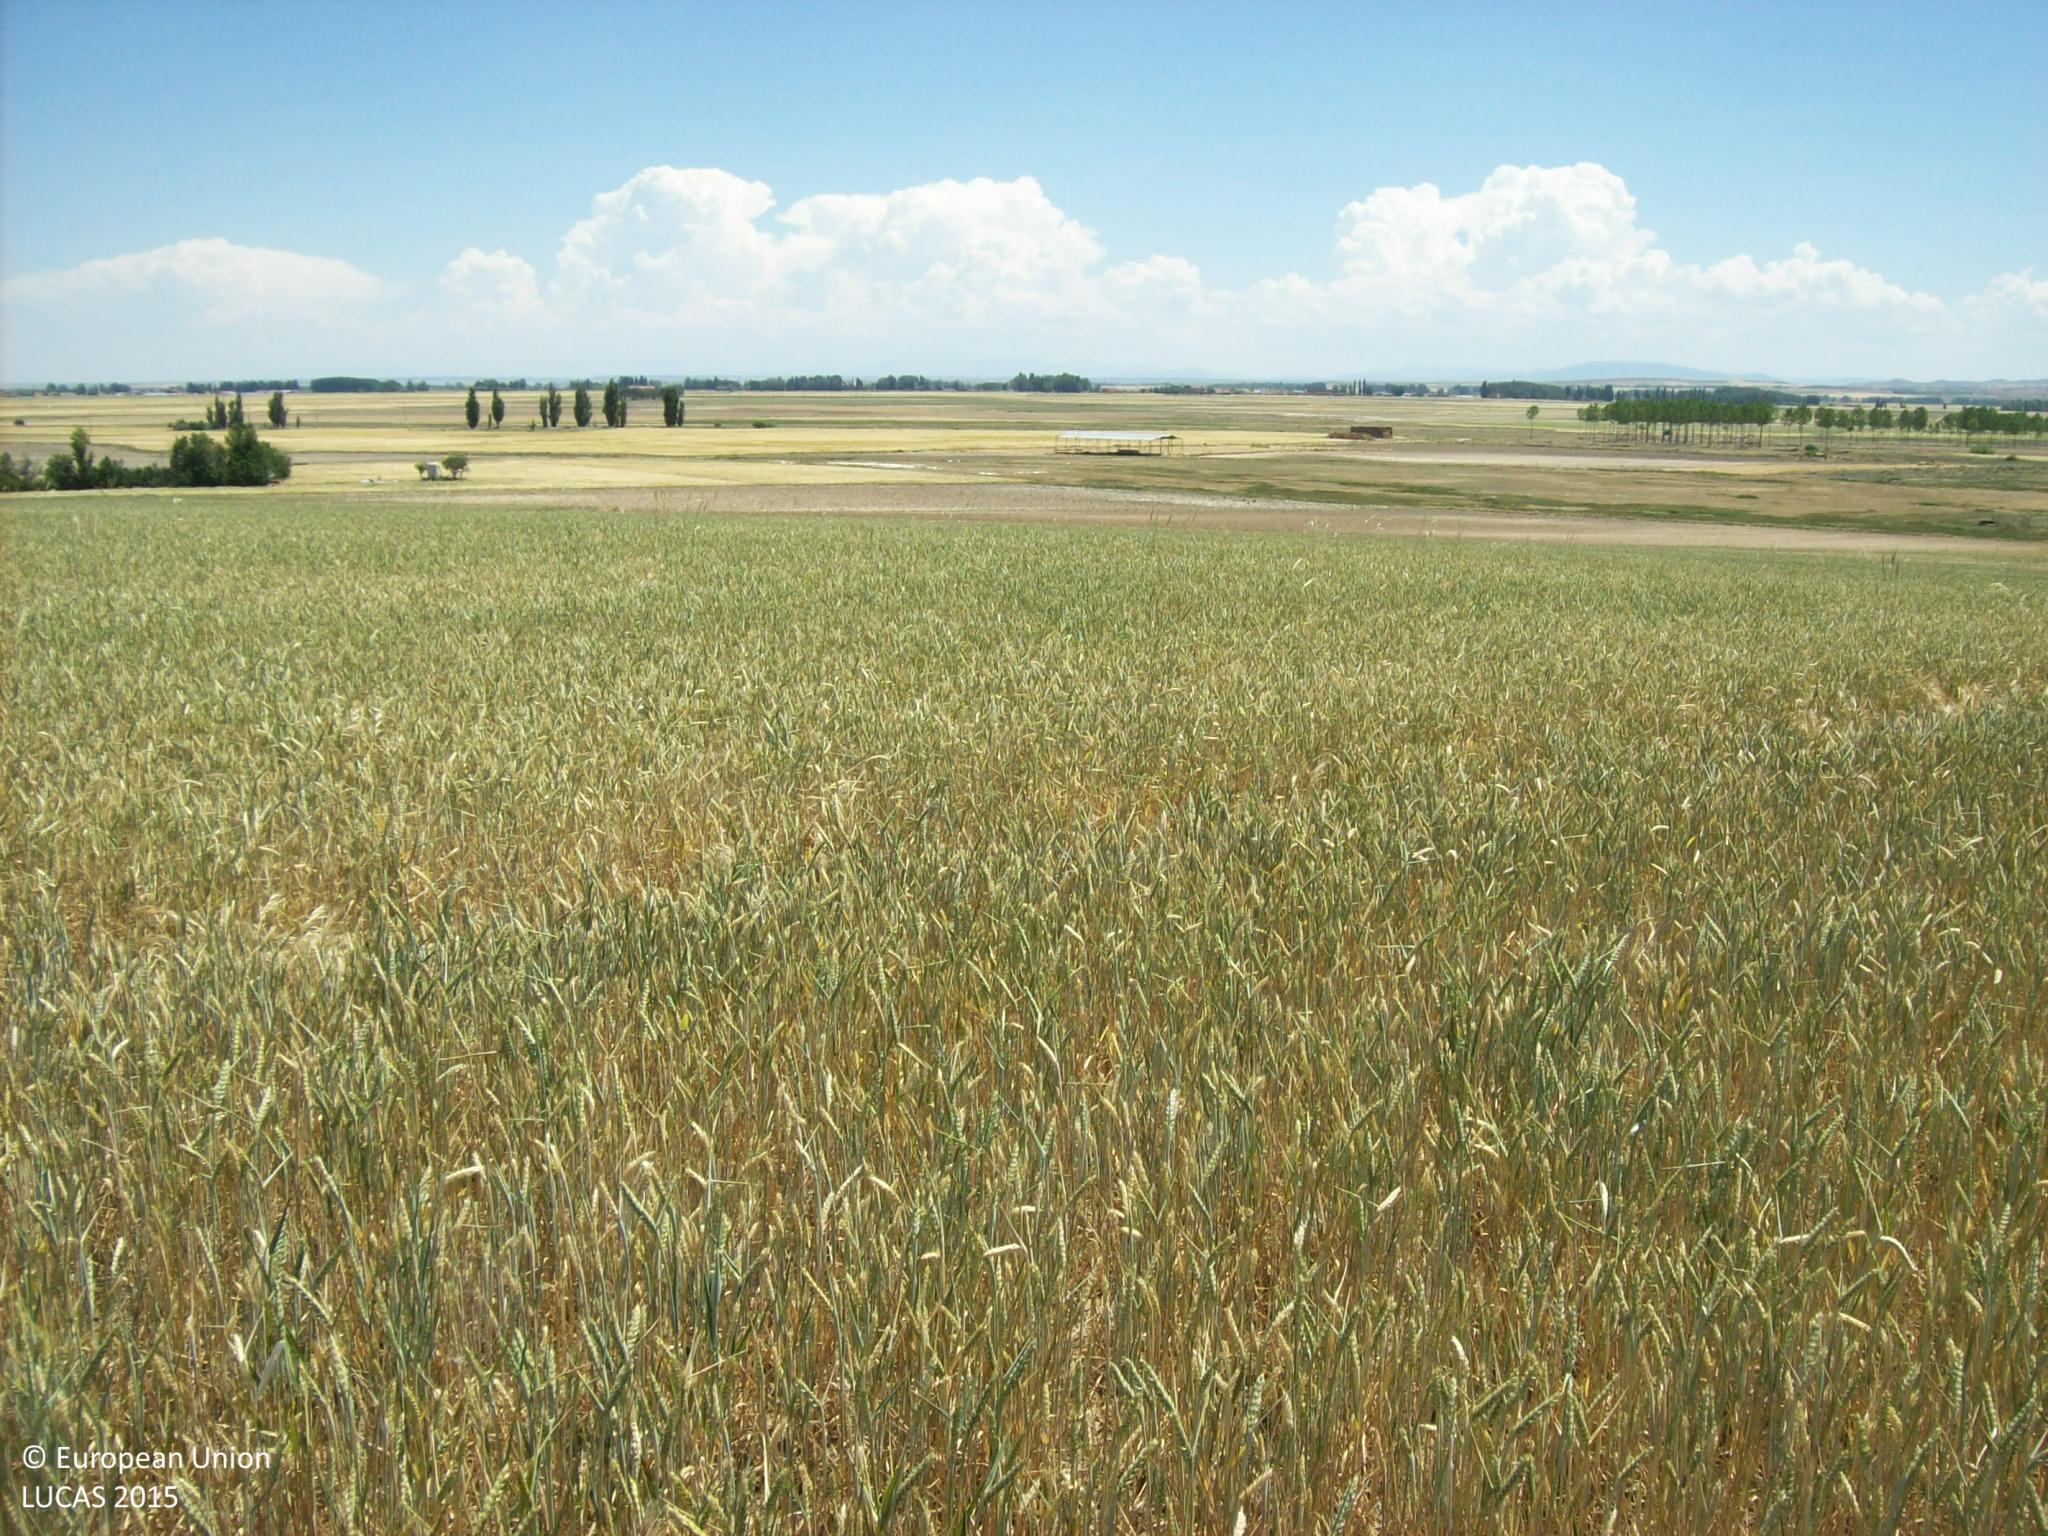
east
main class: Cropland
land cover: Common wheat
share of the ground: > 75 %
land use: Agriculture (excluding fallow land and kitchen gardens)
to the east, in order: Common wheat; Grass margins; Other bare soil; Grass margins; Other bare soil
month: May
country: ES
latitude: 40.8443
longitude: -4.9233
